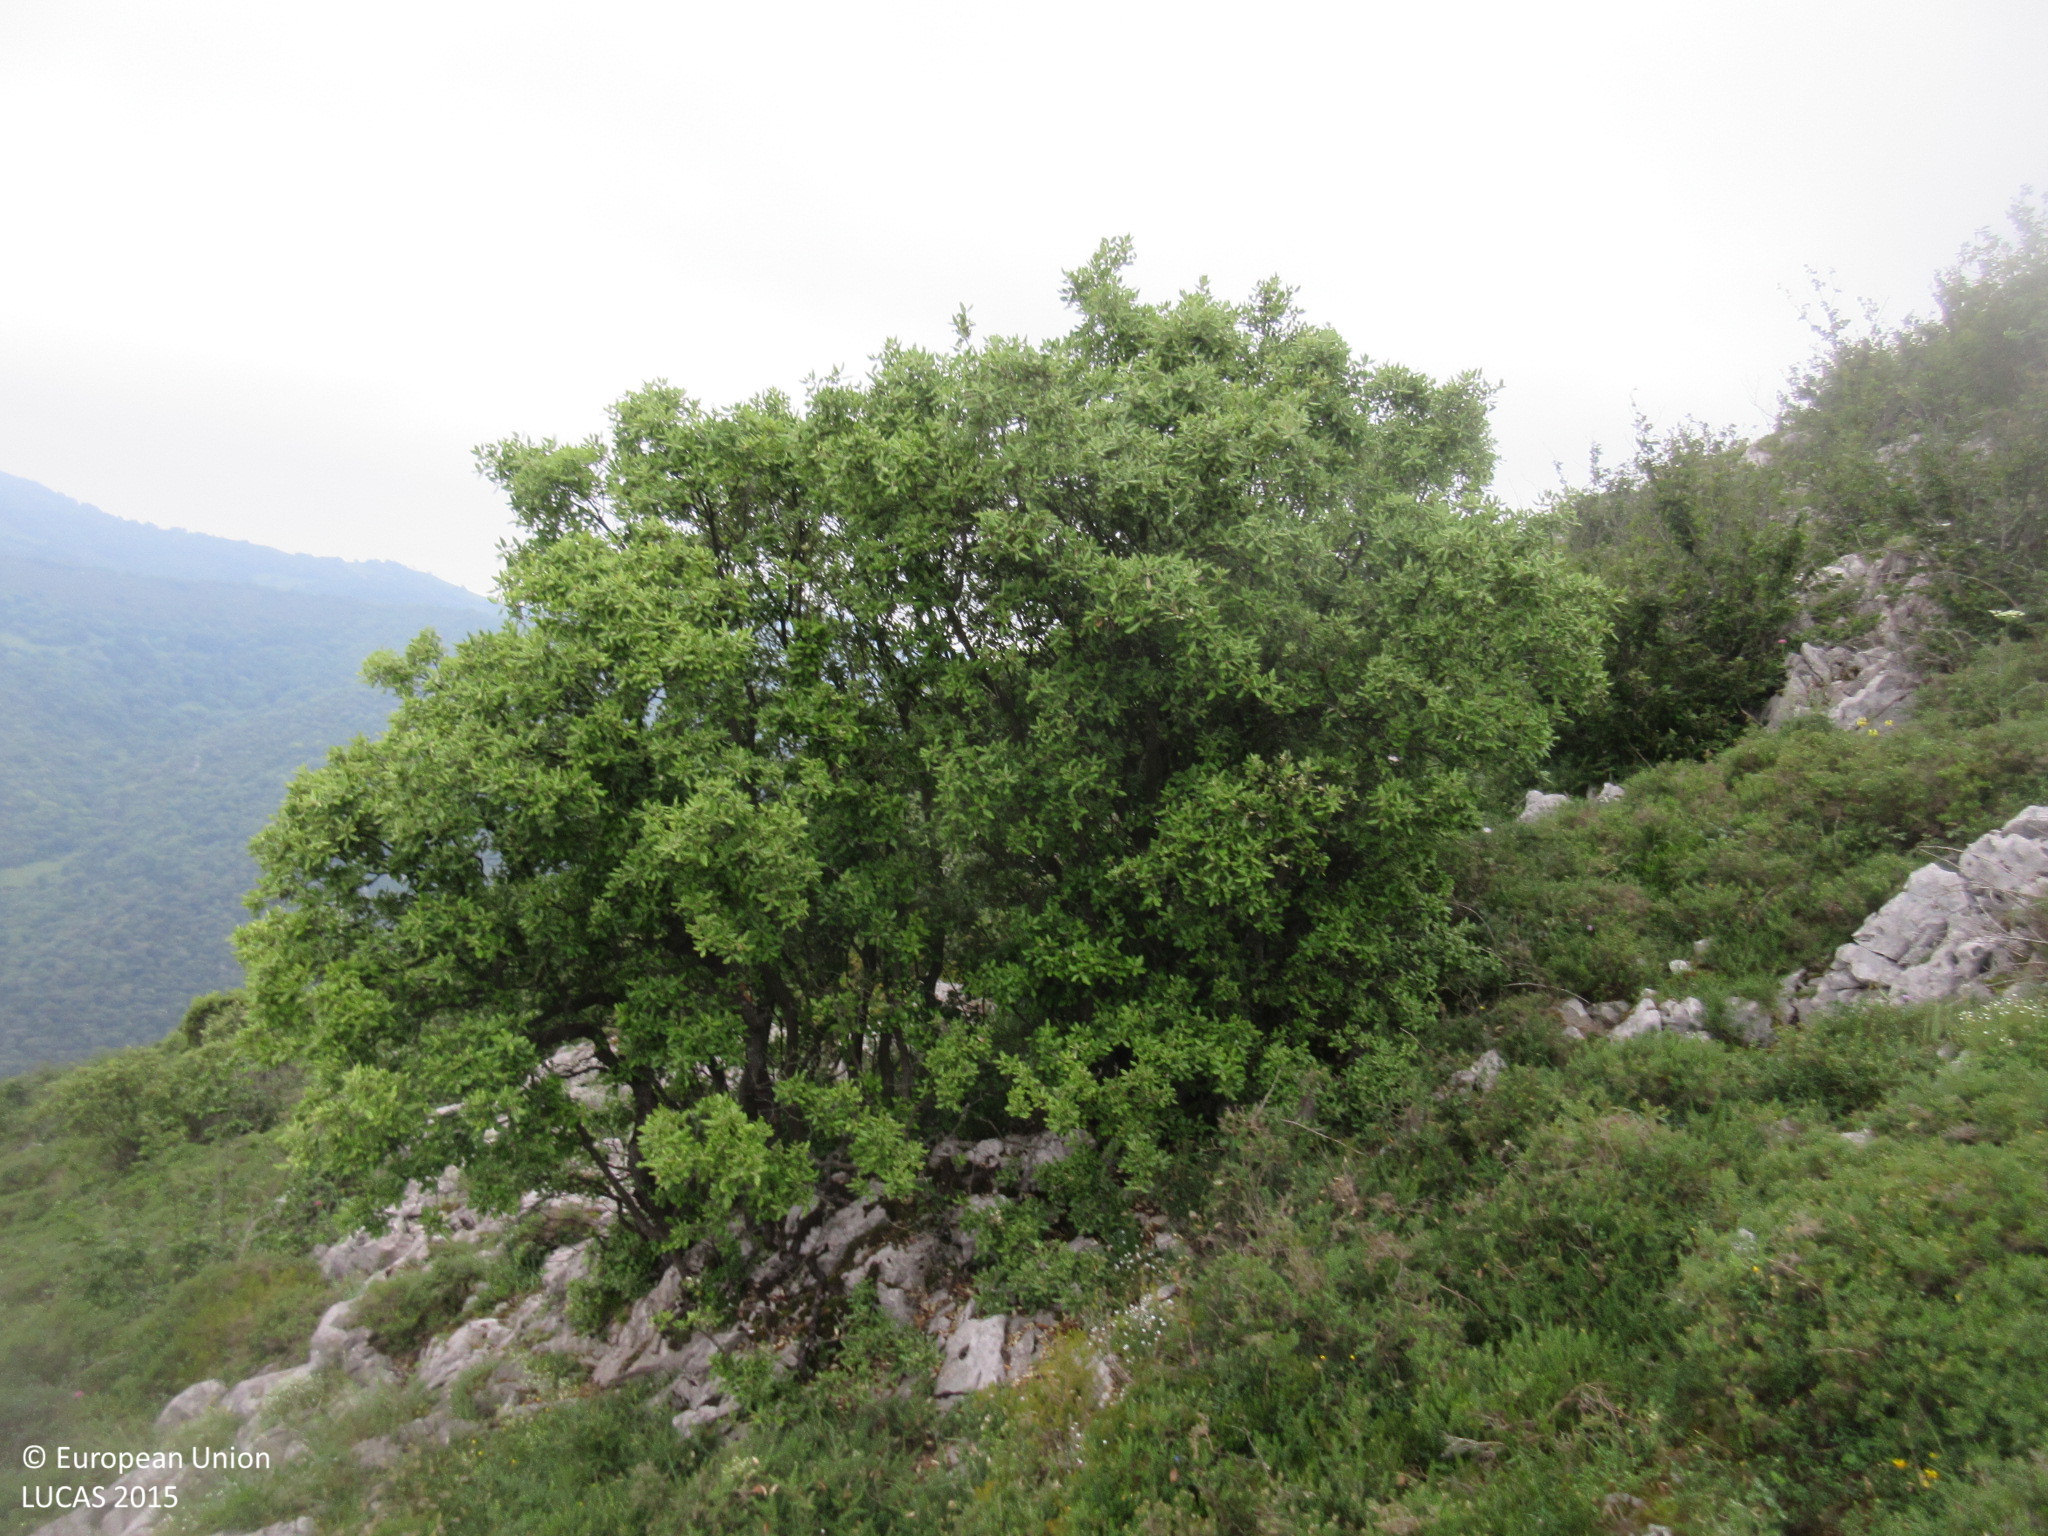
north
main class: Woodland
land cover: Broadleaved woodland
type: broadleaved evergreen forest
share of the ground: 50 - 75 %
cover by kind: broadleaved forest trees 55 %, consolidated bare surface 30 %, shrubs 15 %
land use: Semi-natural and natural areas not in use
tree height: < 5 m
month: June
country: ES
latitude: 43.2654
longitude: -5.9949
